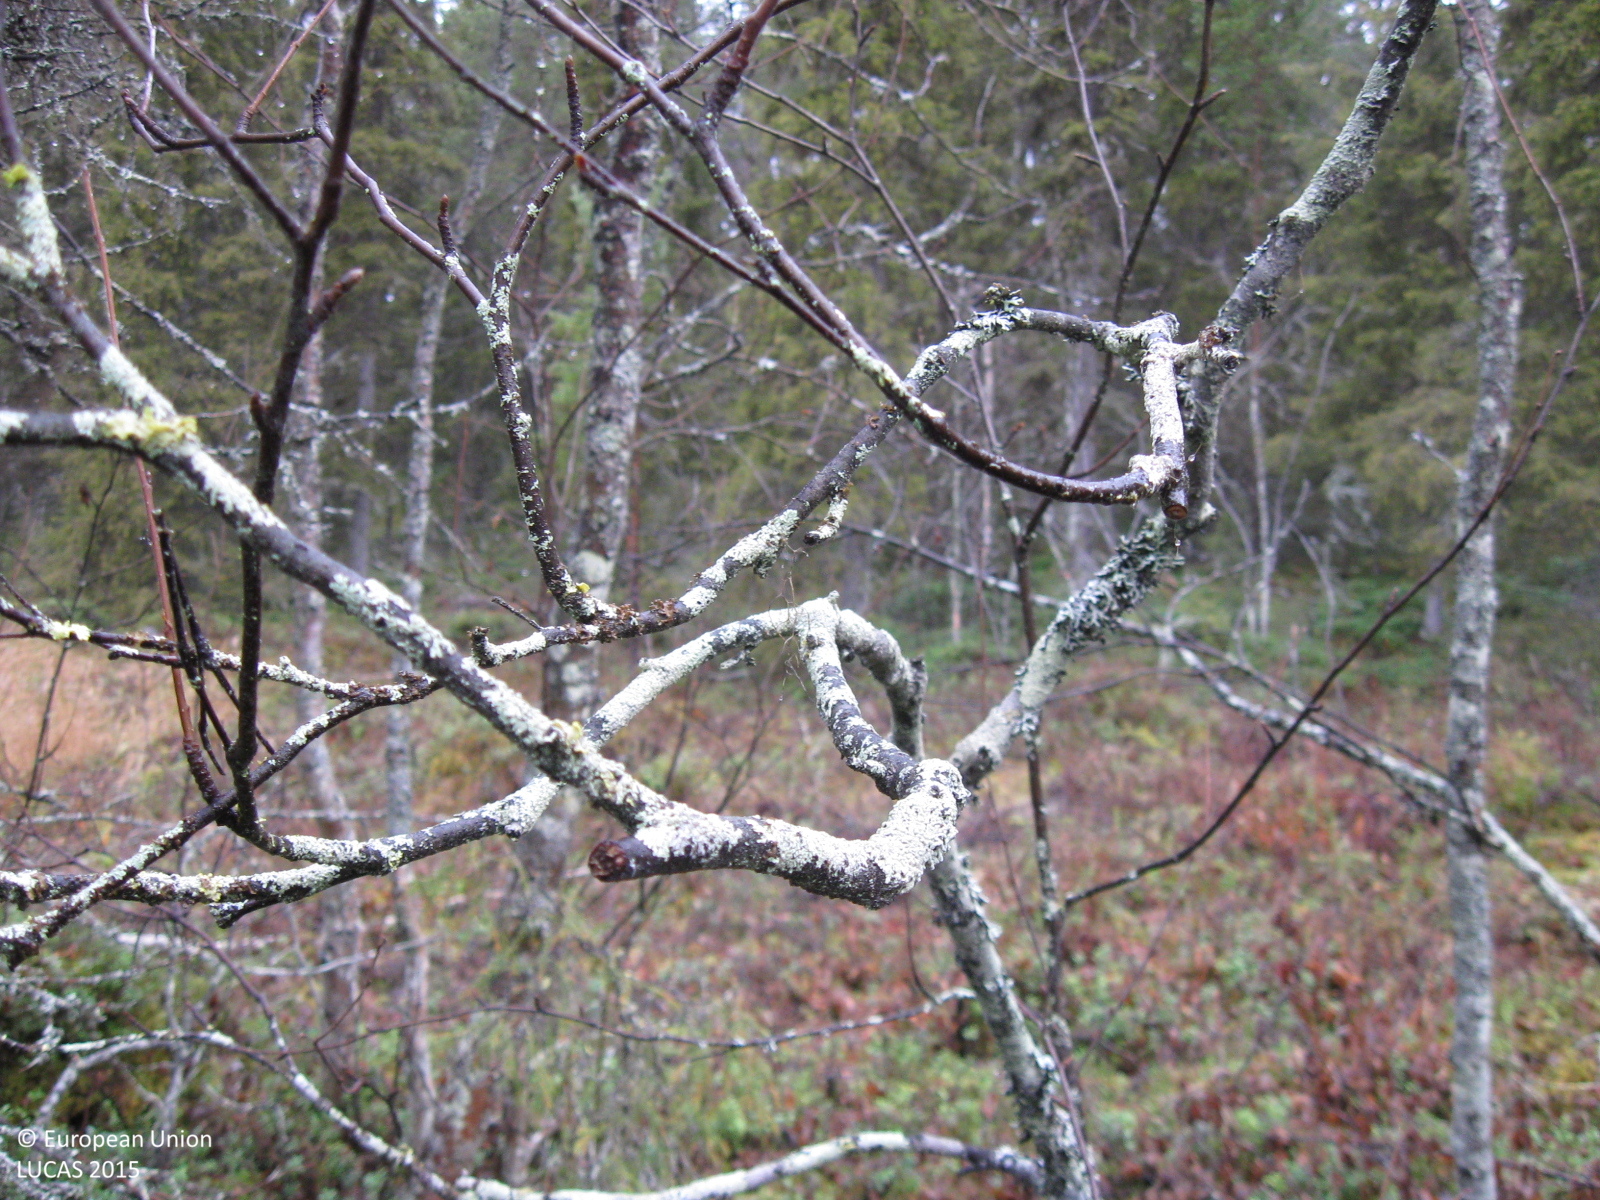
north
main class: Woodland
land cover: Spruce dominated mixed woodland
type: boreal forest
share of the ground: > 75 %
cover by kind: coniferous forest trees 50 %, broadleaved forest trees 30 %, shrubs 10 %, herbaceous plants 5 %, lichens and mosses 5 %
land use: Forestry
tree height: > 5 m
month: October
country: SE
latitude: 66.7548
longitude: 21.0596
